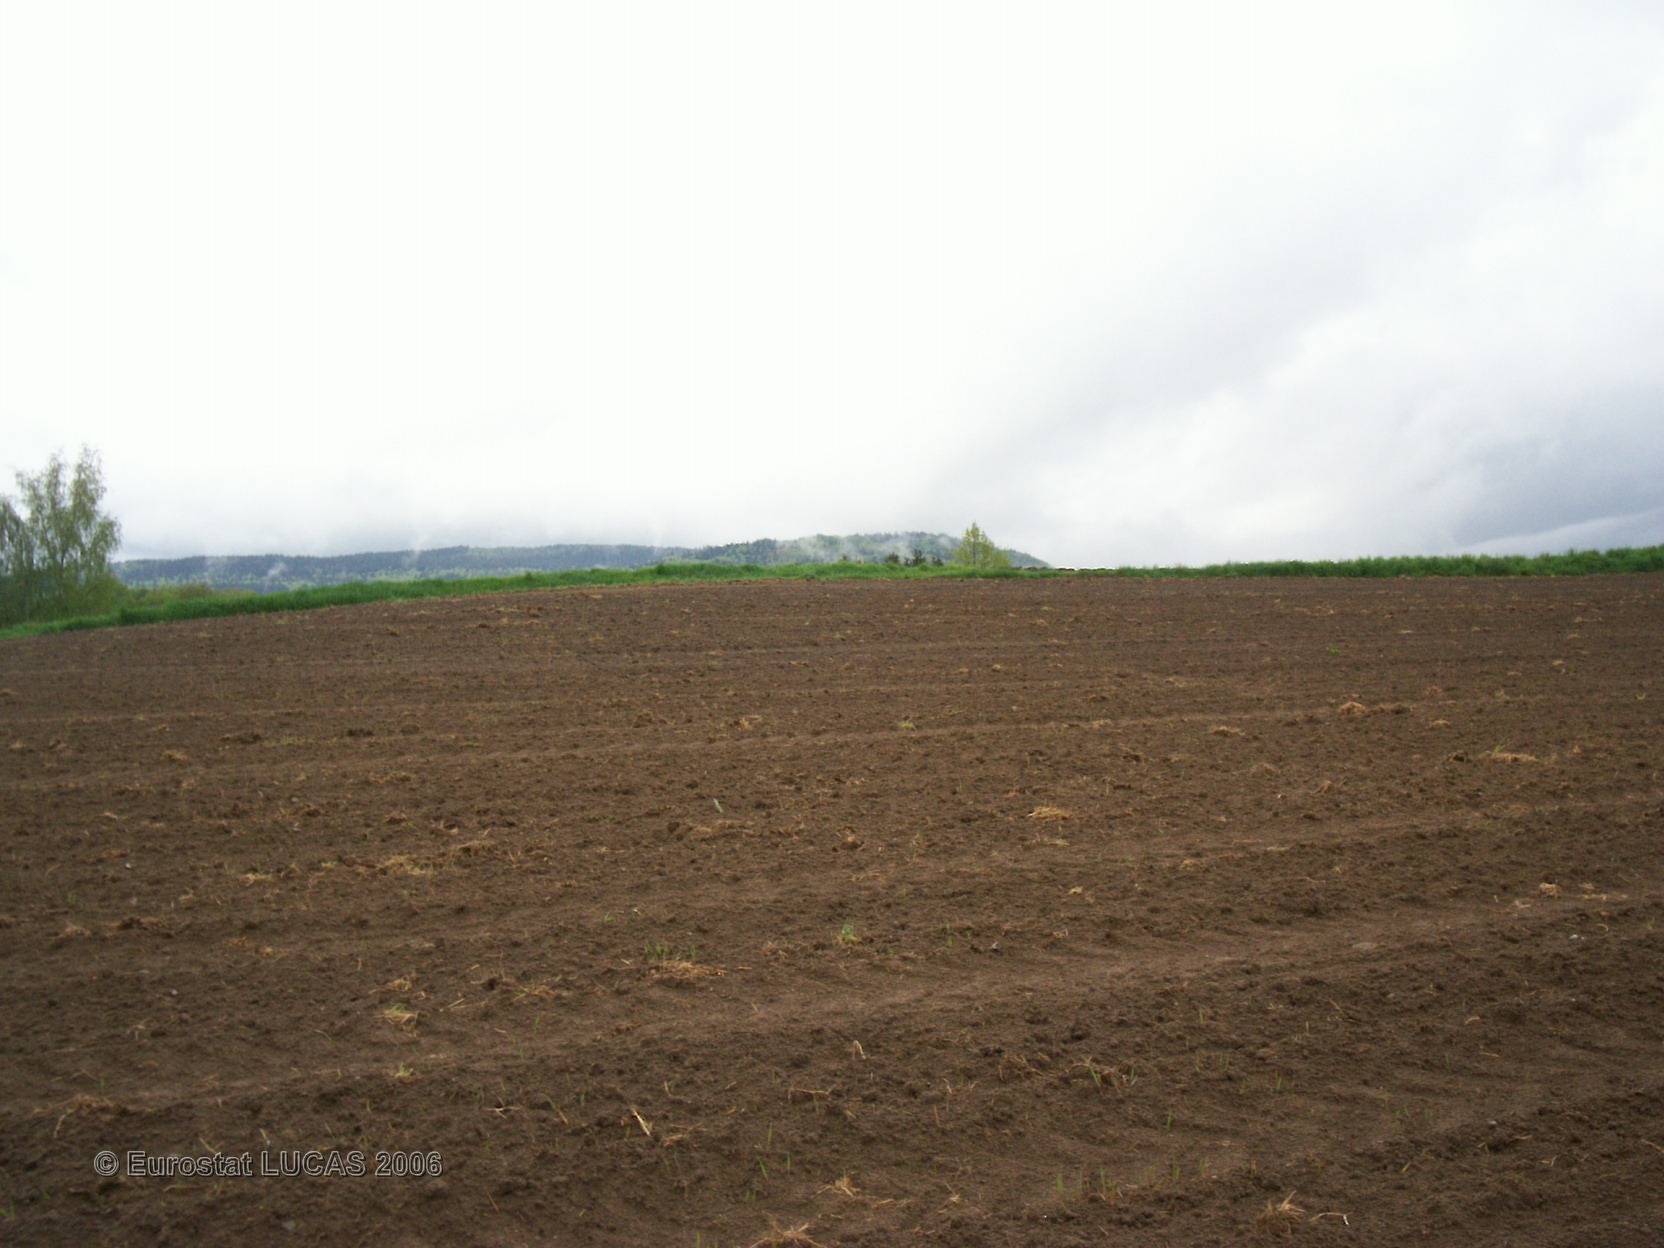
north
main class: Cropland
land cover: Maize
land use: Agriculture (excluding fallow land and kitchen gardens)
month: May
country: FR
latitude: 46.0282
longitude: 6.1151
